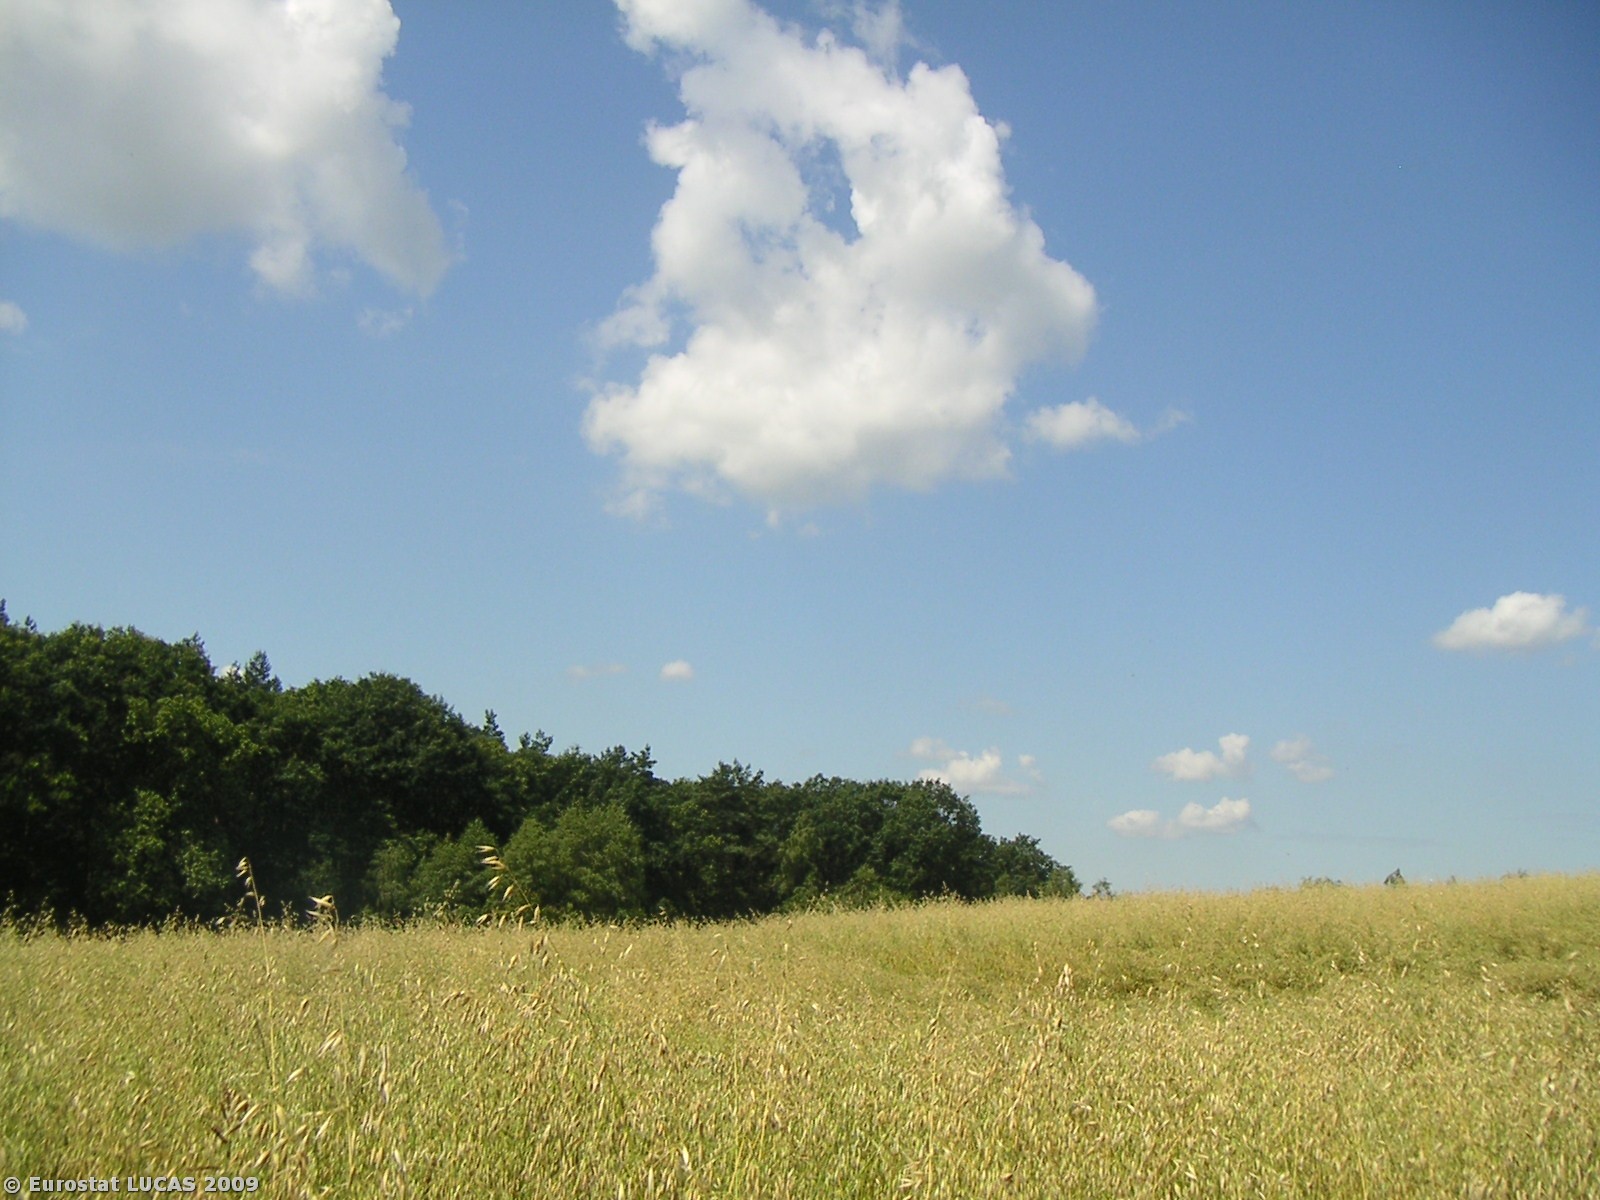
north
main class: Cropland
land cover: Oats
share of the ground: 50 - 75 %
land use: Agriculture (excluding fallow land and kitchen gardens)
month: July
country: PL
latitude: 50.0030
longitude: 19.7260
